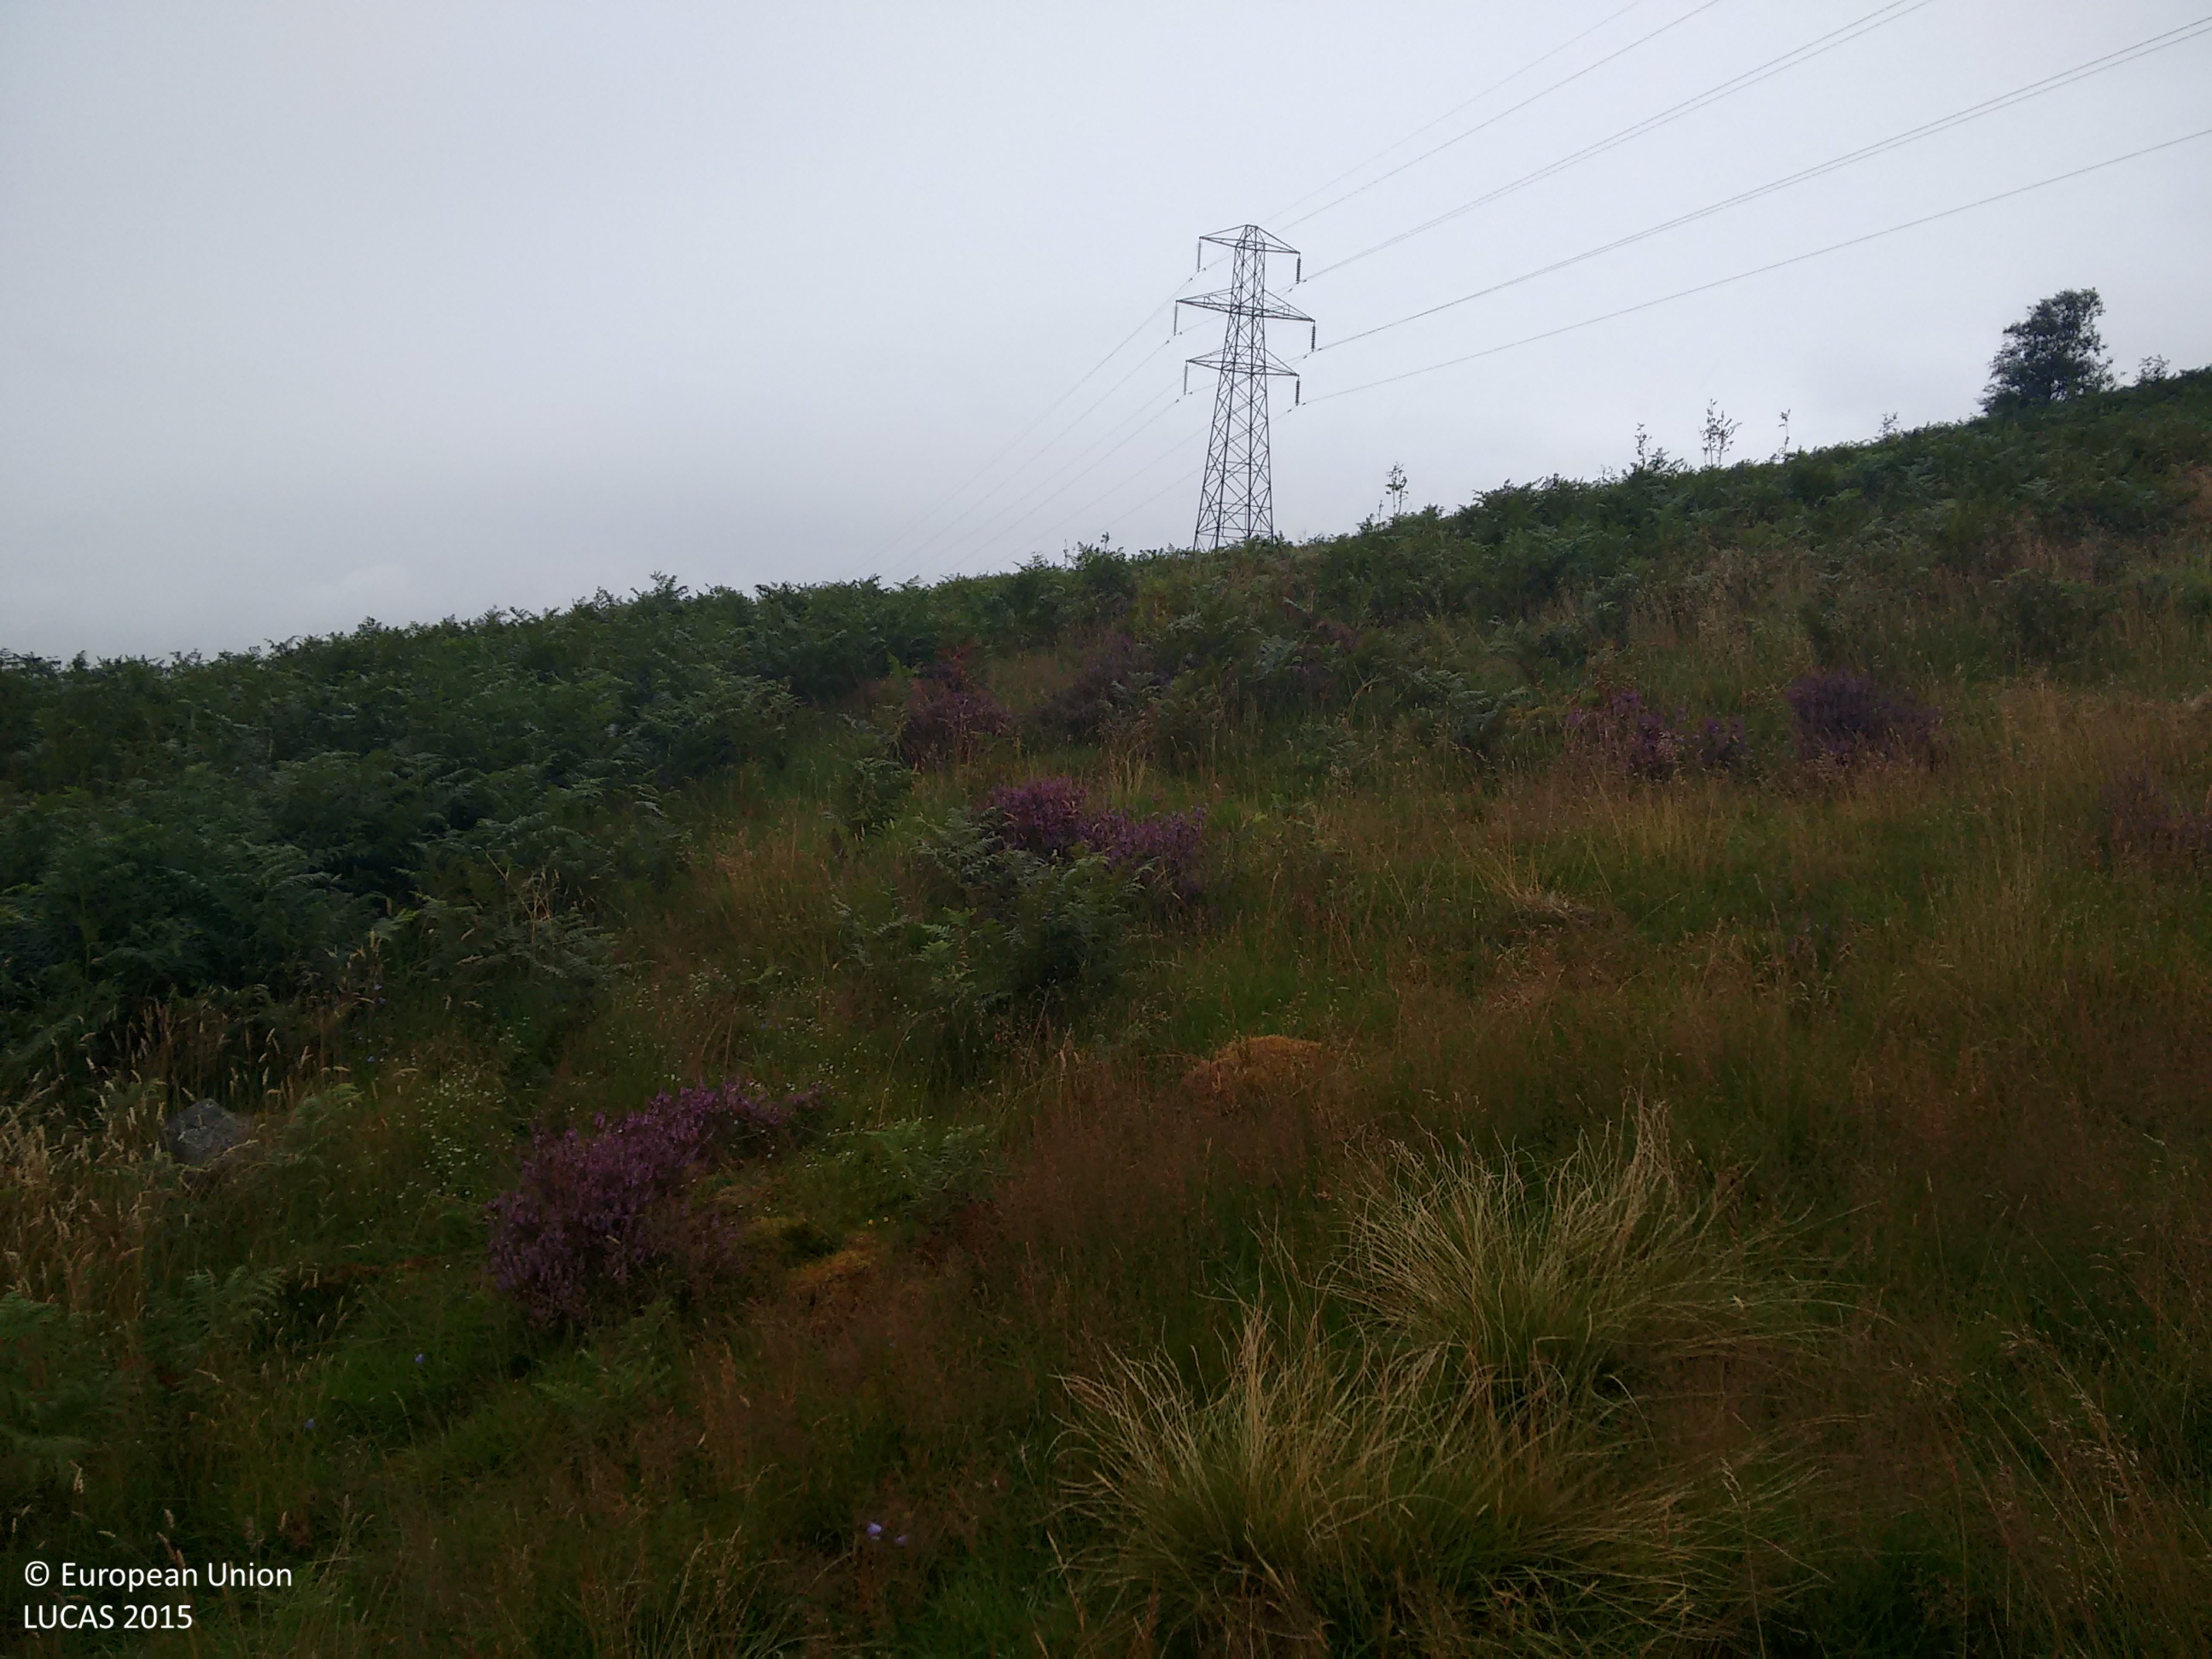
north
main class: Grassland
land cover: Grassland without tree/shrub cover
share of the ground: > 75 %
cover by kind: herbaceous plants 95 %, shrubs 5 %
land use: Semi-natural and natural areas not in use
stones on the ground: < 10 %
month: August
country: GB
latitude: 55.1417
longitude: -2.9820
